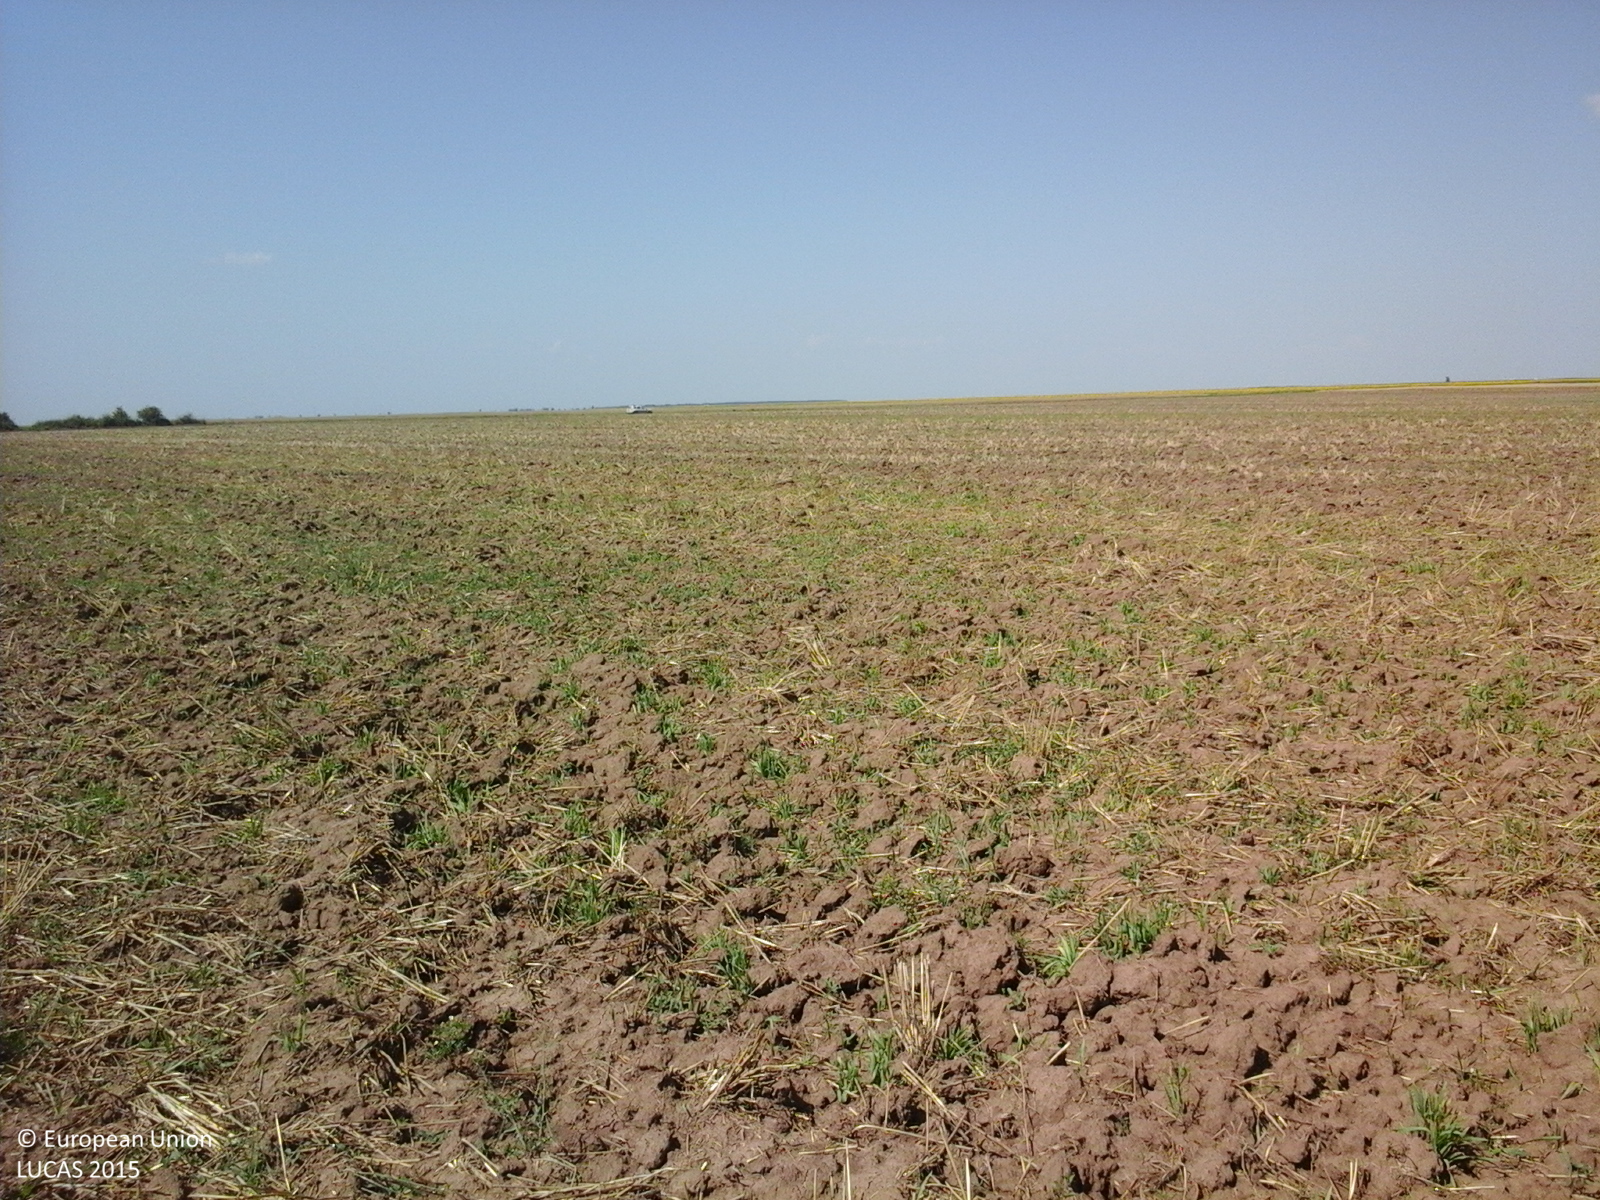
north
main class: Cropland
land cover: Durum wheat
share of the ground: < 10 %
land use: Agriculture (excluding fallow land and kitchen gardens)
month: July
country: RO
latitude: 44.1977
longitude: 24.5462
